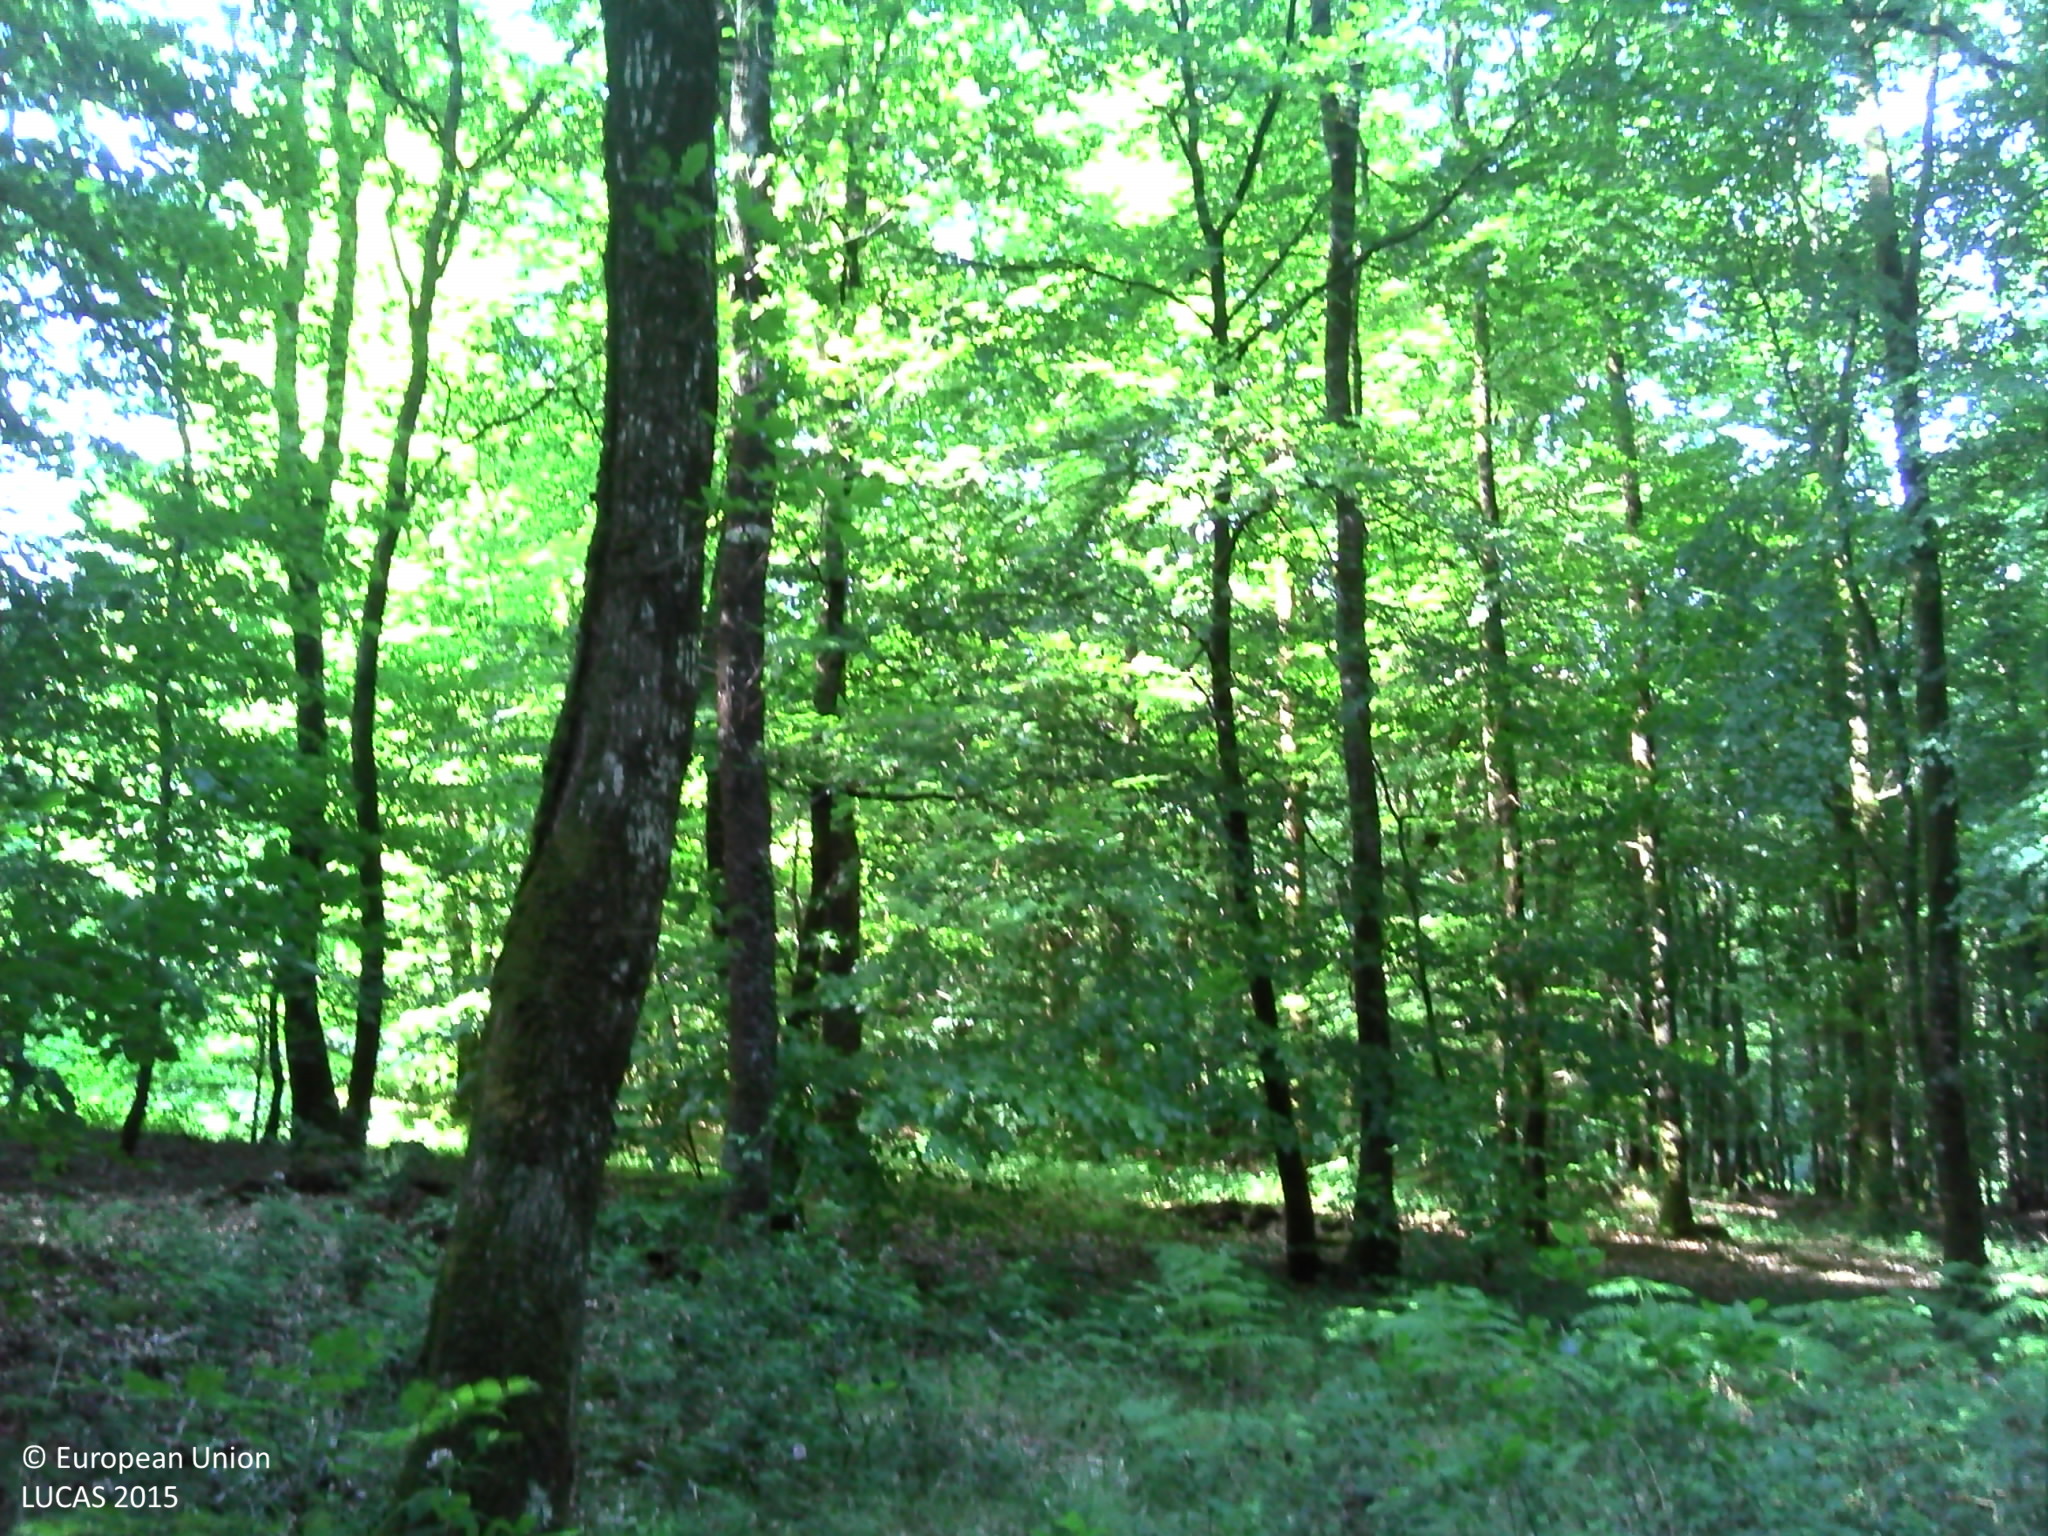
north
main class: Woodland
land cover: Broadleaved woodland
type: acidophilous oak and oak-birch forest
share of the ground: > 75 %
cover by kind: broadleaved forest trees 70 %, shrubs 15 %, herbaceous plants 15 %
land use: Forestry
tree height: > 5 m
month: June
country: FR
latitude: 48.3849
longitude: 0.2100
